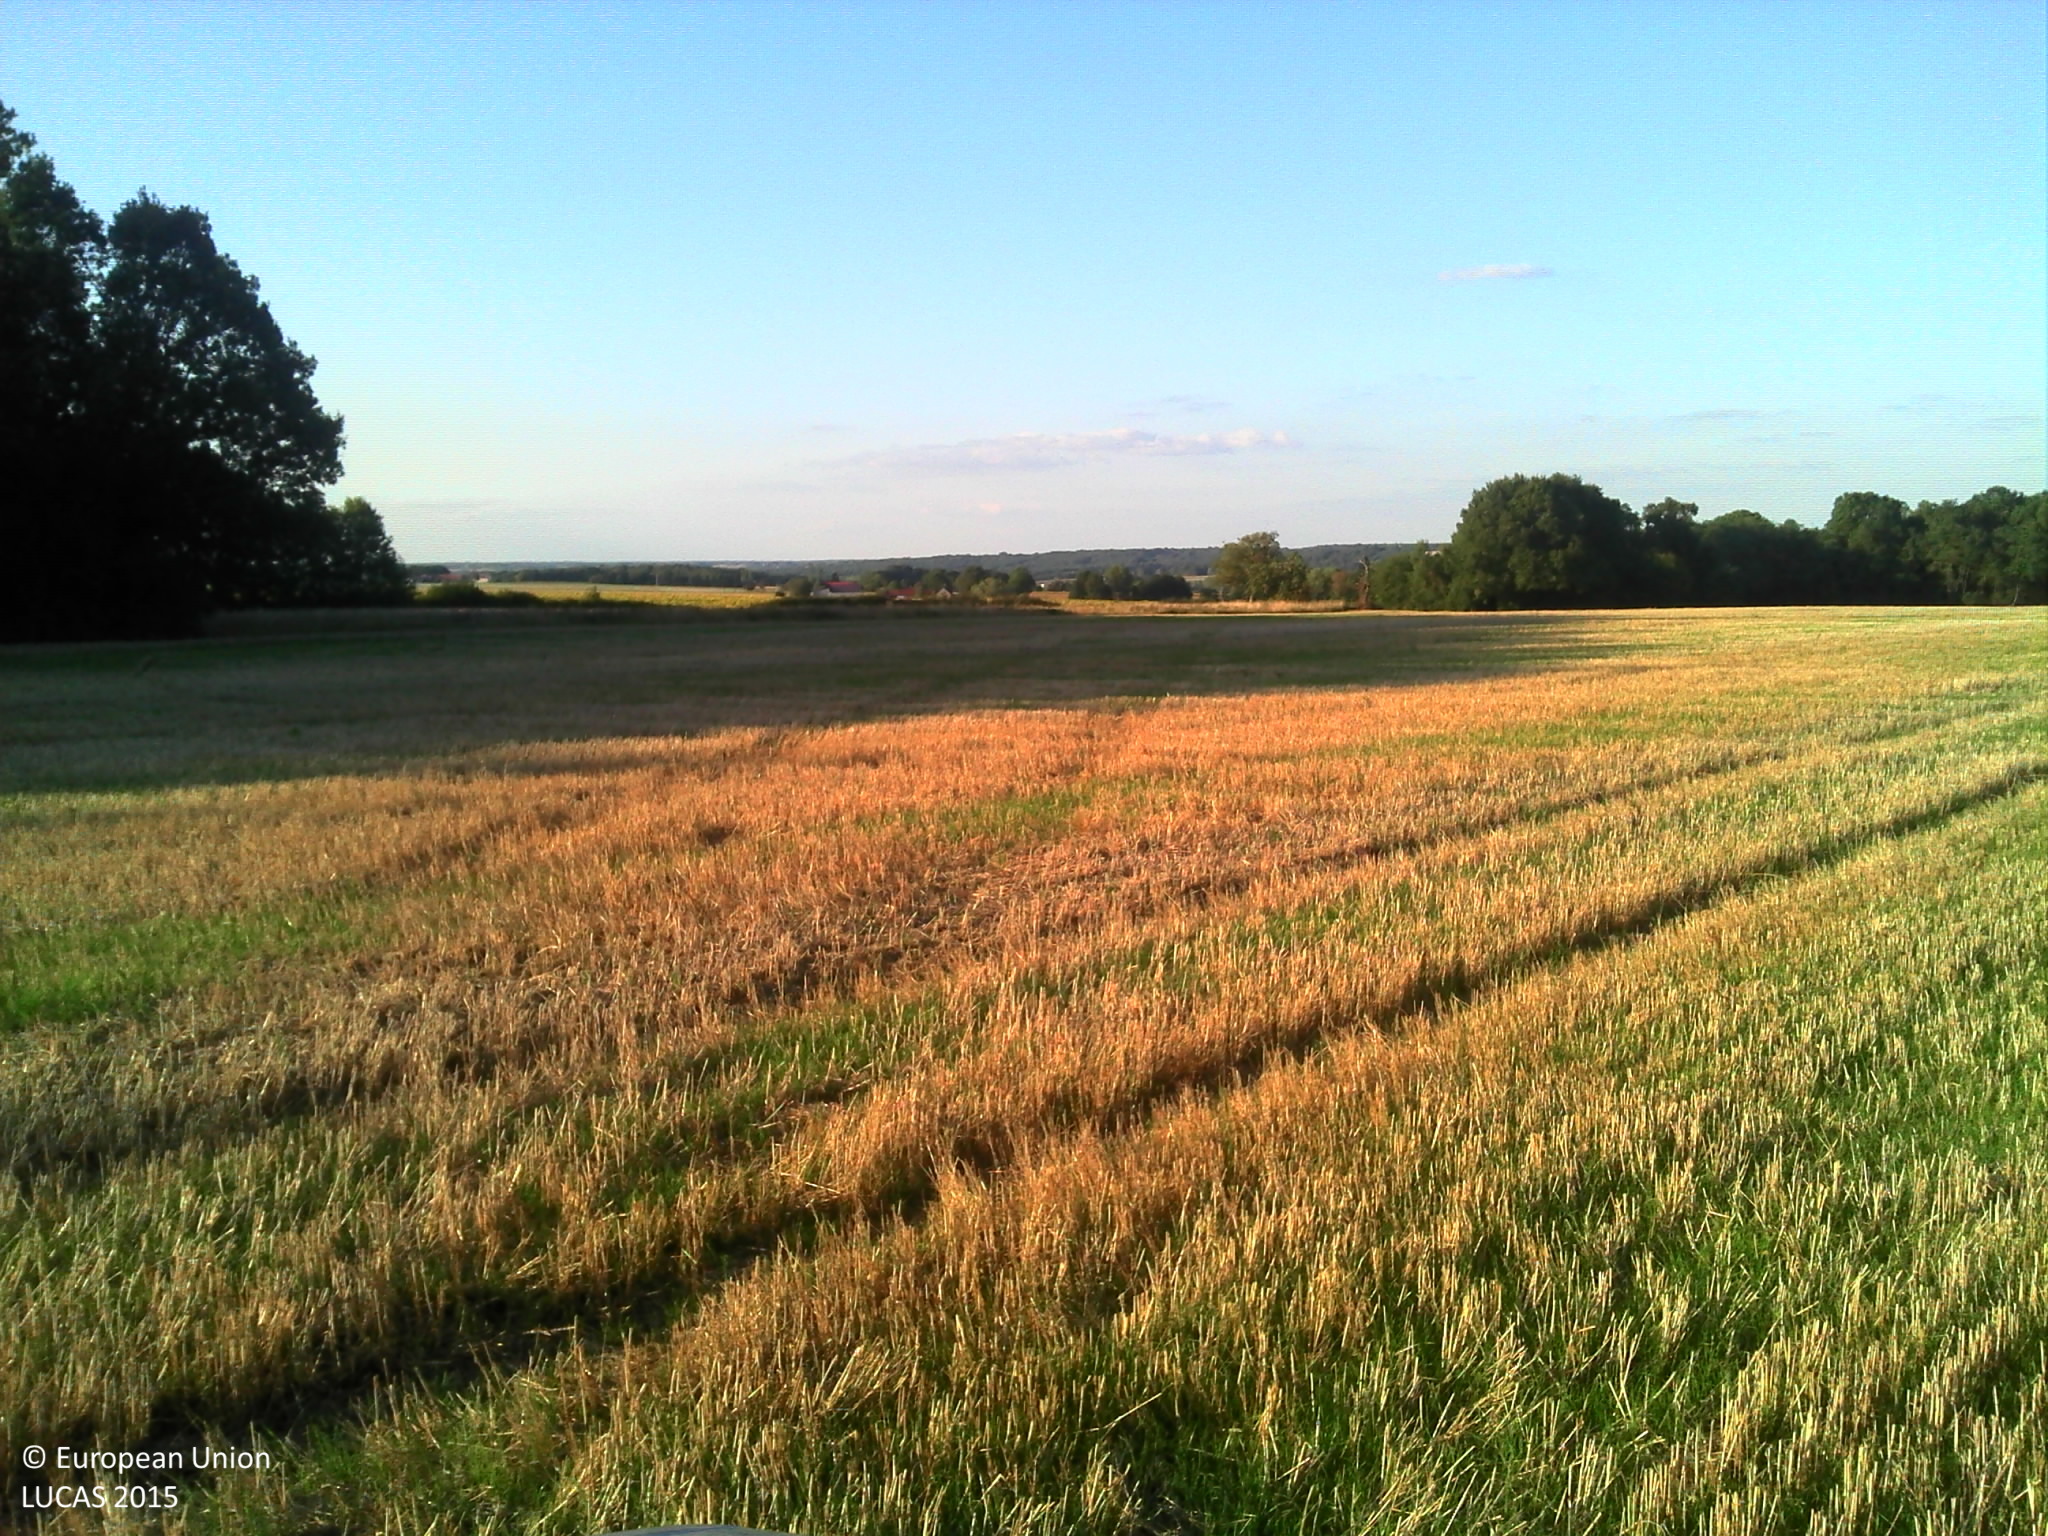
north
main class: Cropland
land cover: Common wheat
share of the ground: > 75 %
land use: Agriculture (excluding fallow land and kitchen gardens)
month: September
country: FR
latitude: 47.0284
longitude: 1.5273
